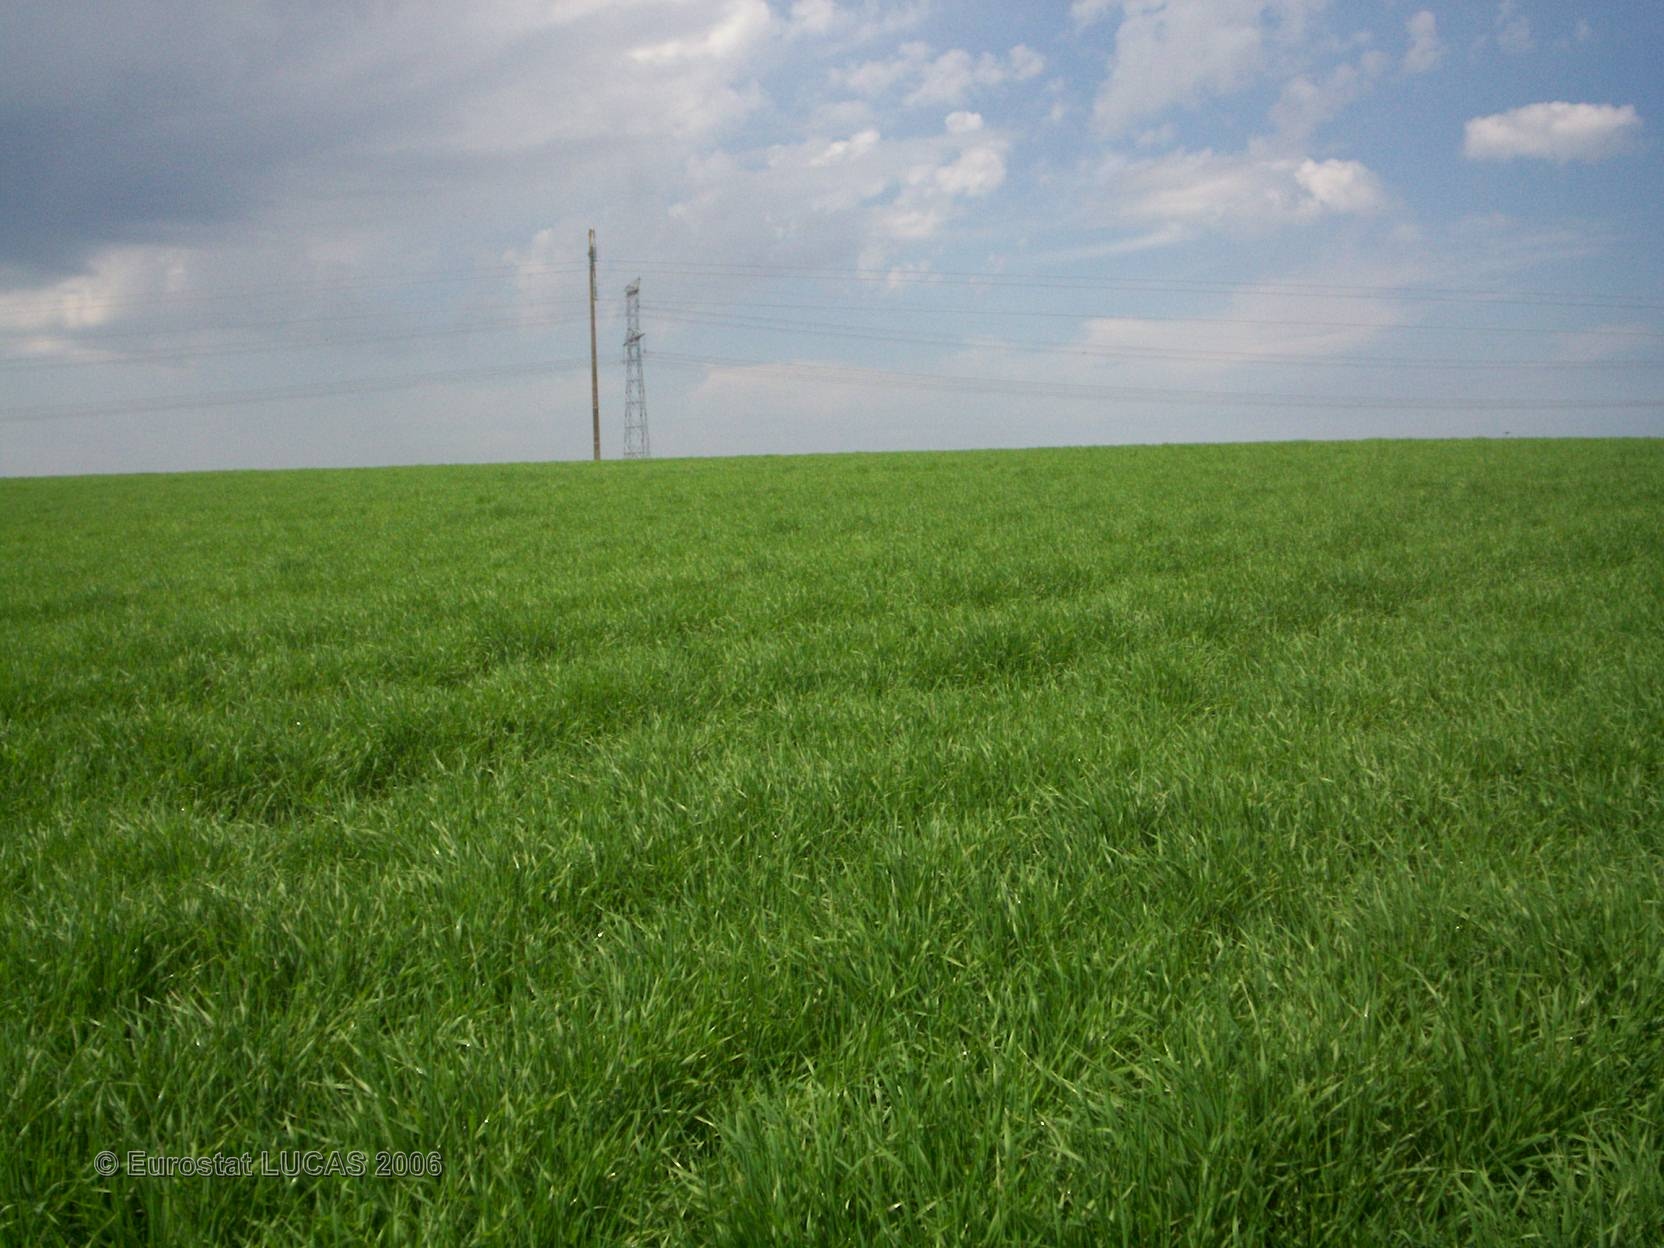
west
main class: Cropland
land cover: Barley
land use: Agriculture (excluding fallow land and kitchen gardens)
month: April
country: FR
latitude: 47.3339
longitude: 3.0207
